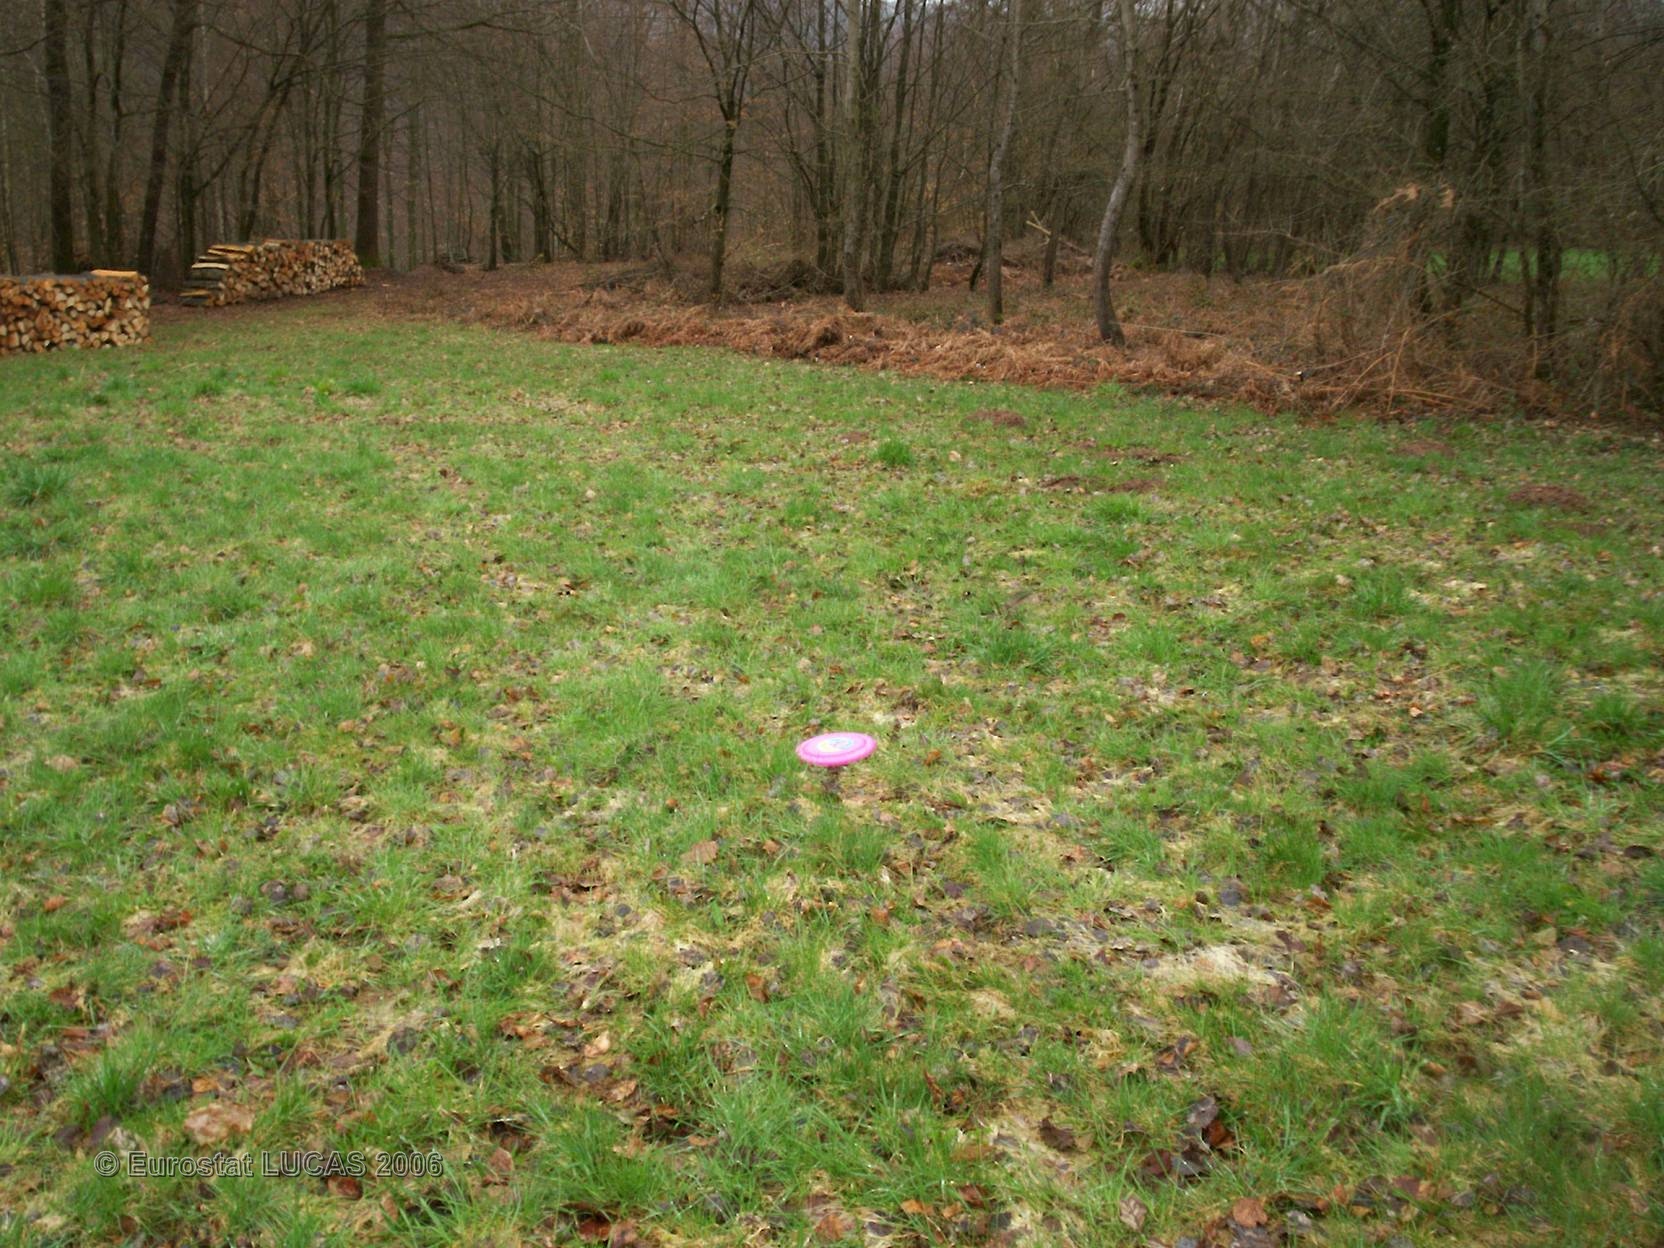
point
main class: Grassland
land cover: Grassland without tree/shrub cover
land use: Agriculture (excluding fallow land and kitchen gardens)
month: April
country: FR
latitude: 47.6498
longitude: 6.6333
